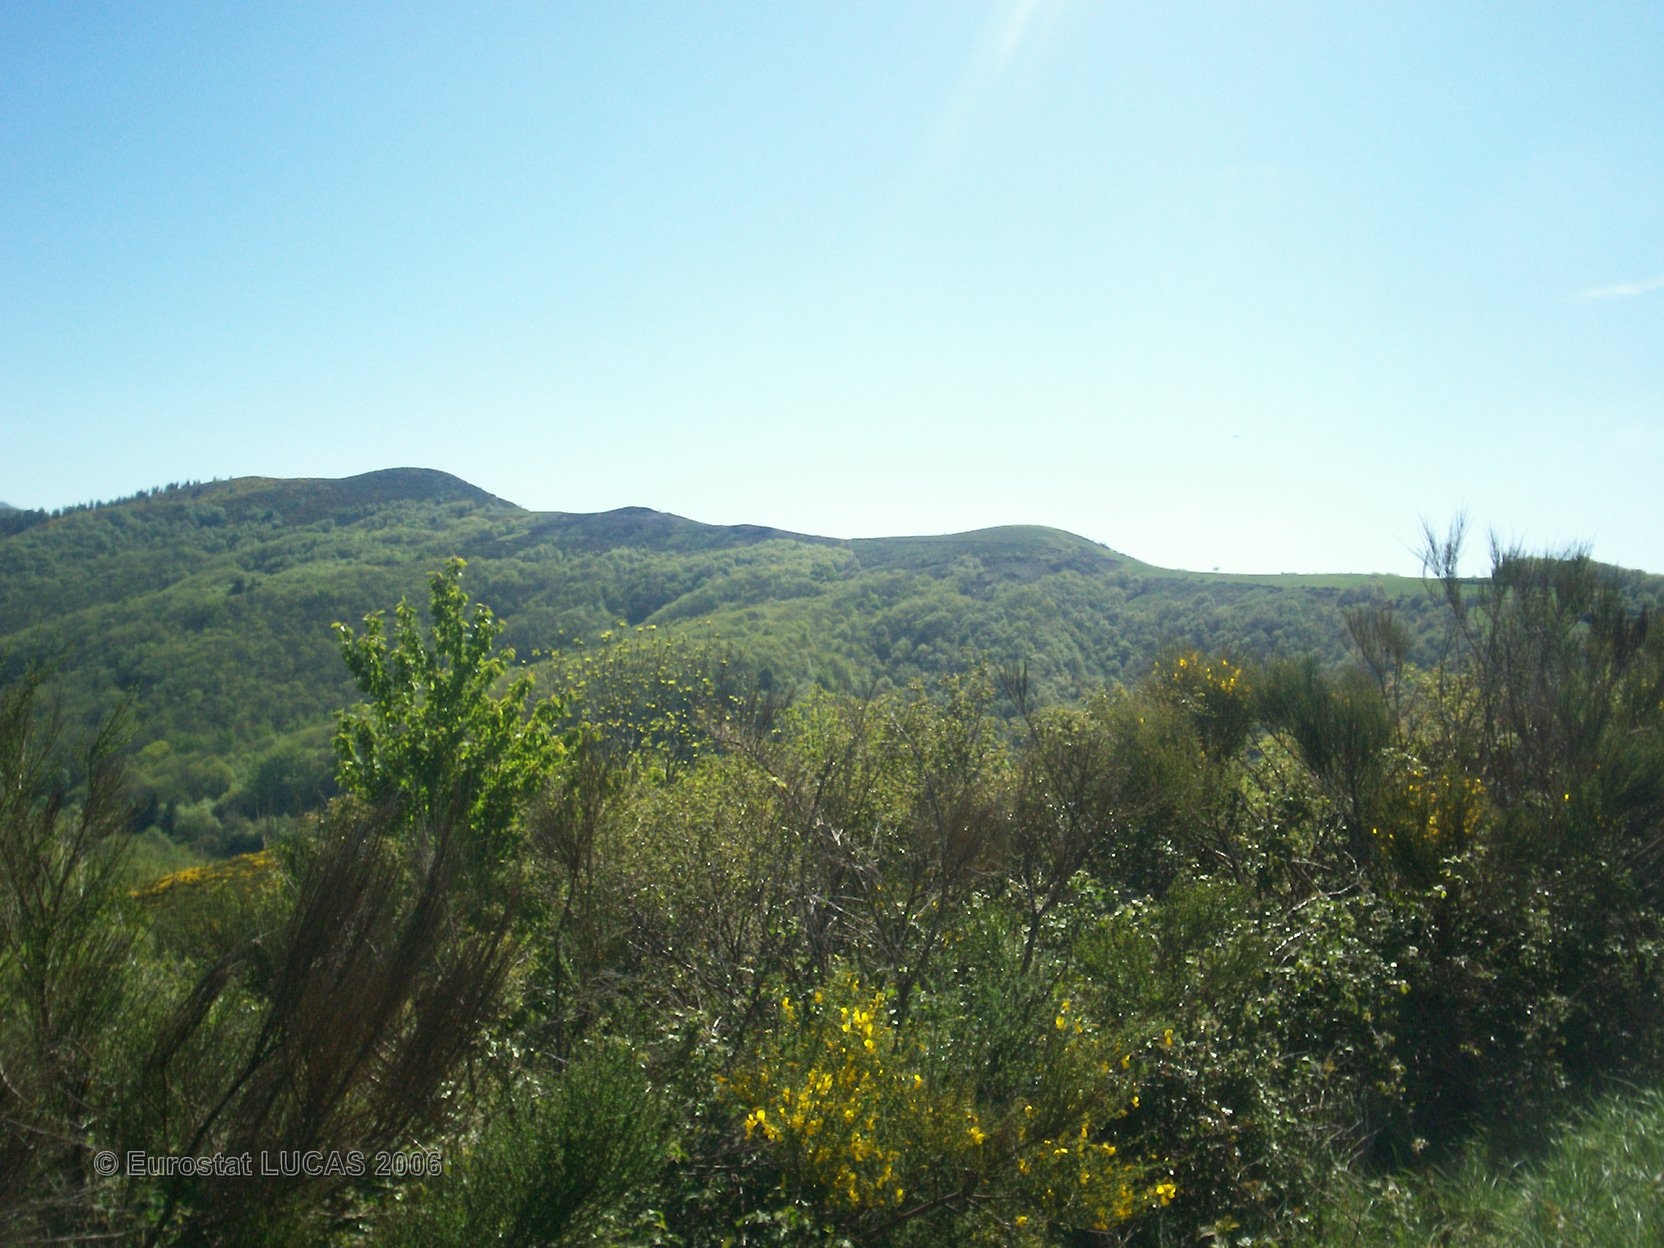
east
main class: Grassland
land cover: Grassland without tree/shrub cover
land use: Agriculture (excluding fallow land and kitchen gardens)
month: May
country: FR
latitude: 43.9799
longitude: 3.4372
